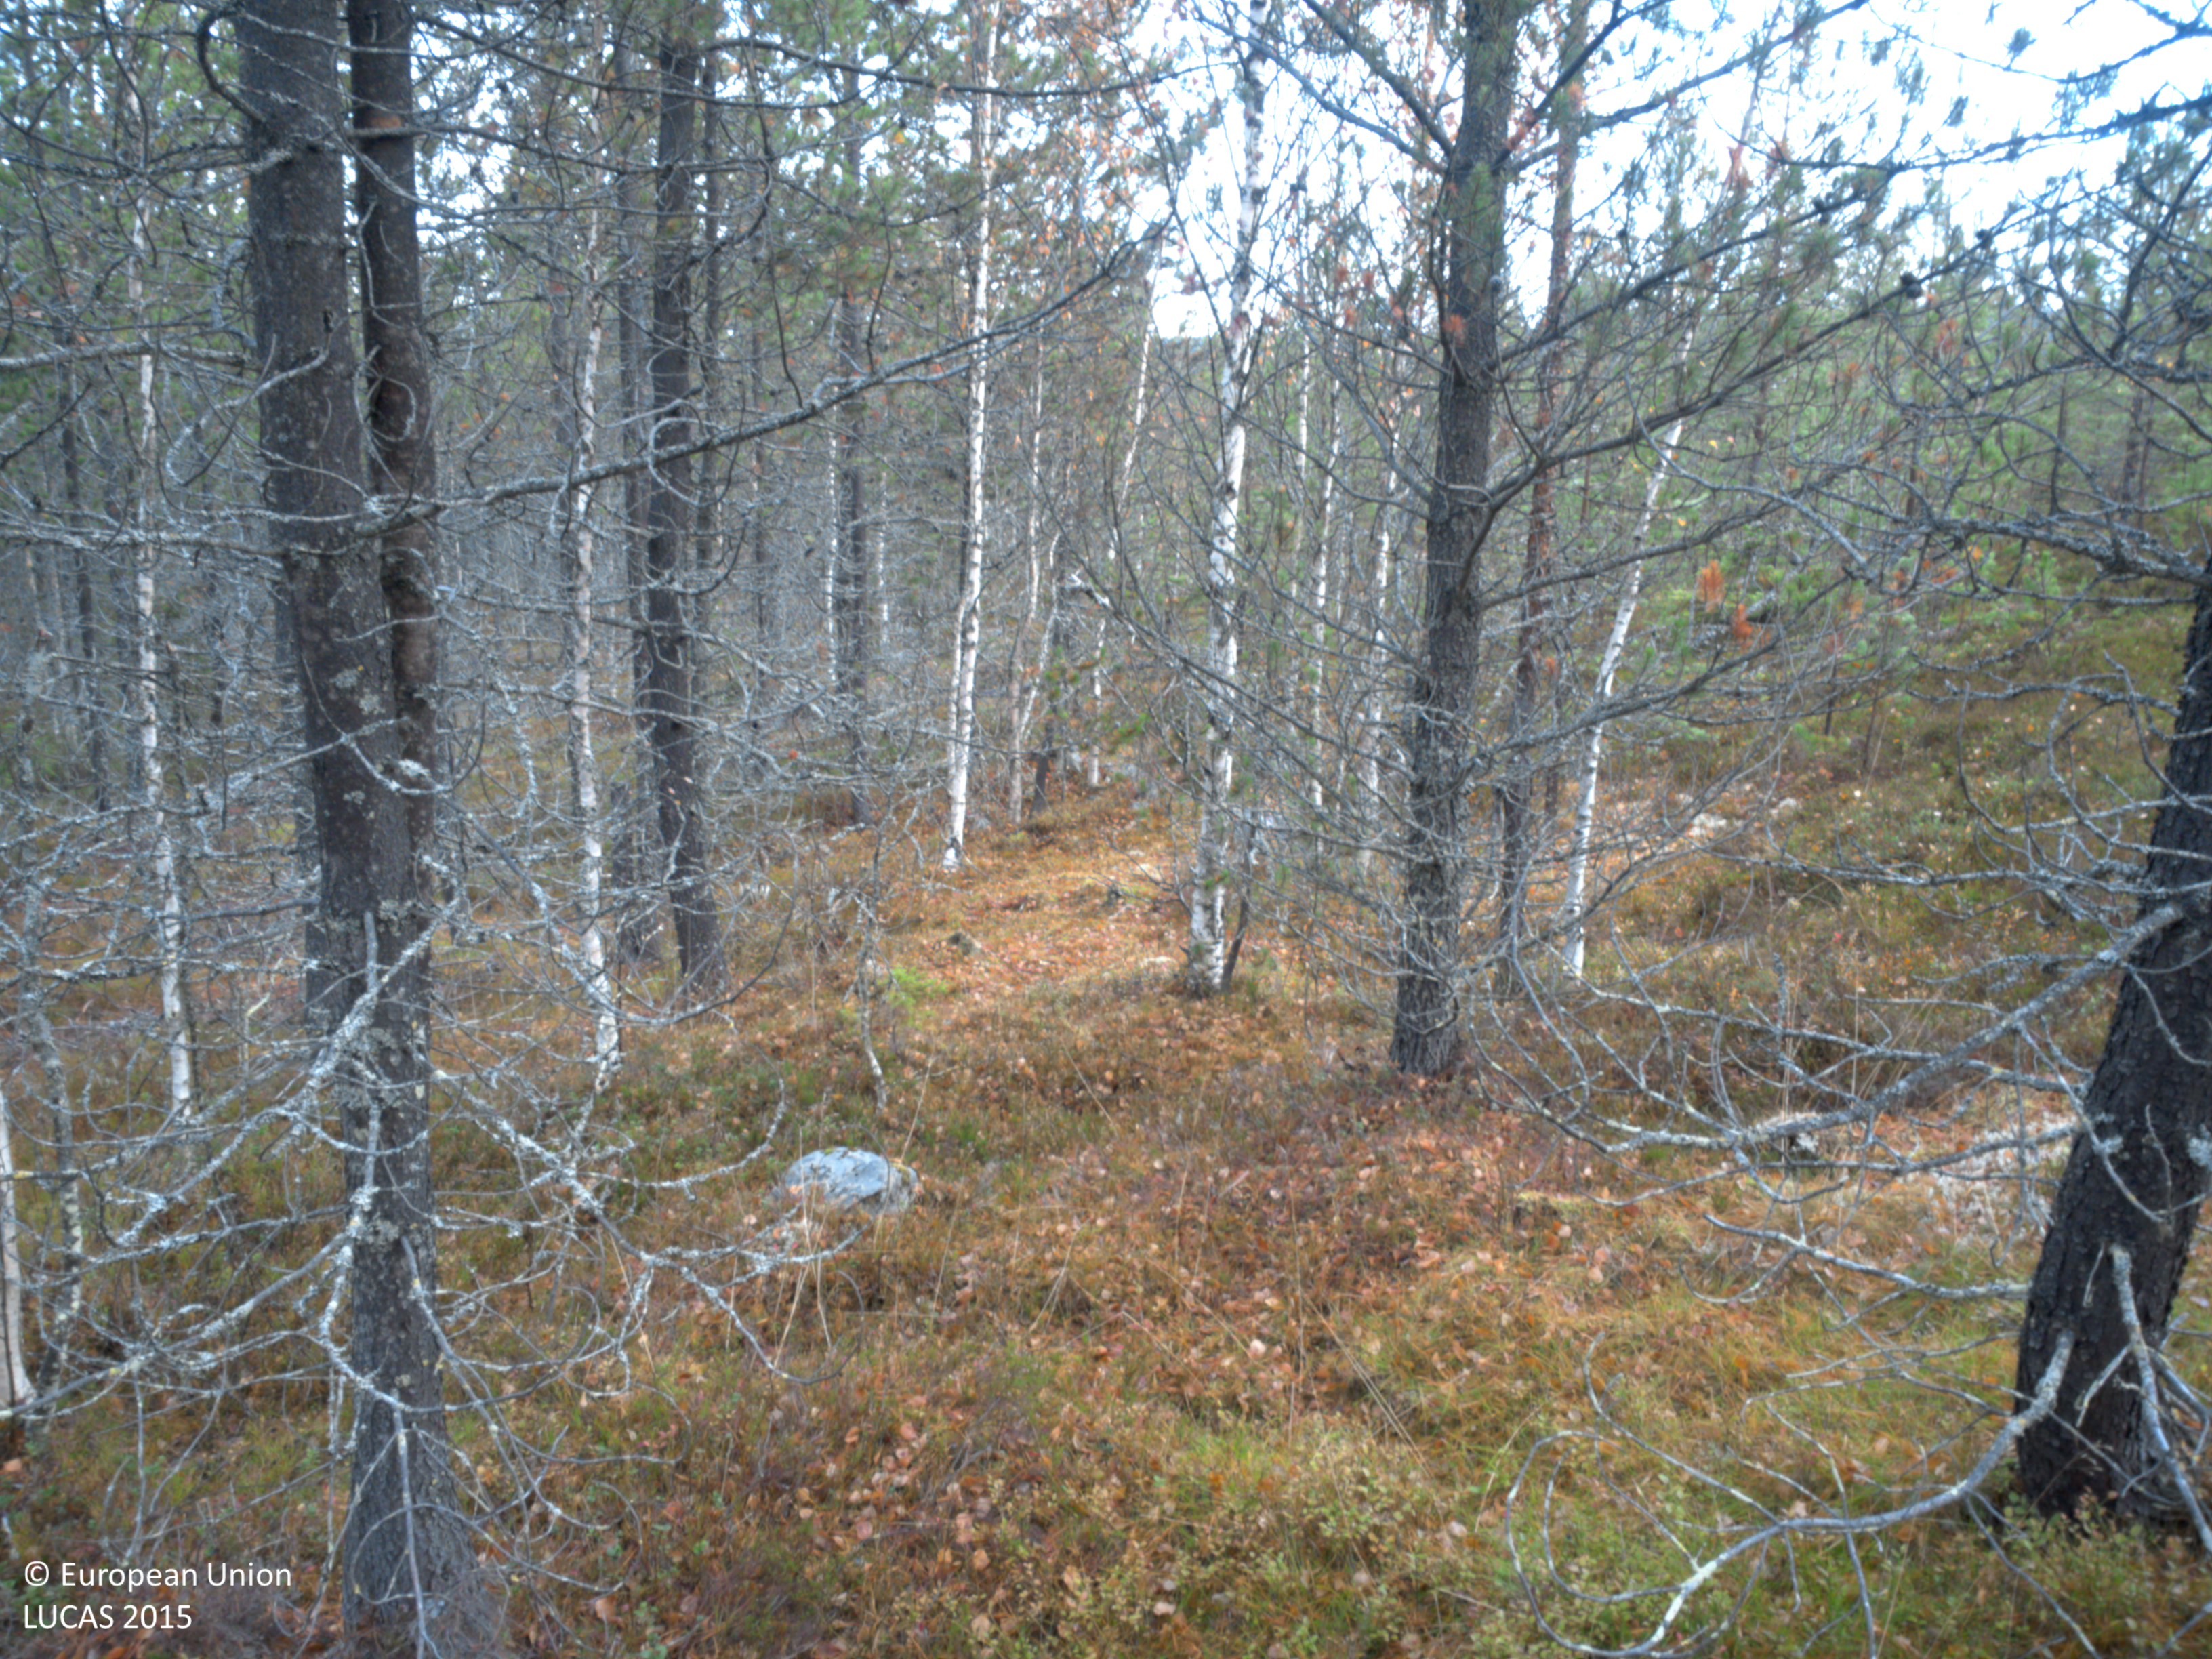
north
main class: Woodland
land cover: Pine dominated coniferous woodland
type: exotic forest
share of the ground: > 75 %
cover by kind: coniferous forest trees 75 %, shrubs 10 %, lichens and mosses 10 %, herbaceous plants 5 %
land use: Forestry
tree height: > 5 m
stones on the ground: 25 - 50 %
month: October
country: SE
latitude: 63.8268
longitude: 18.1211
